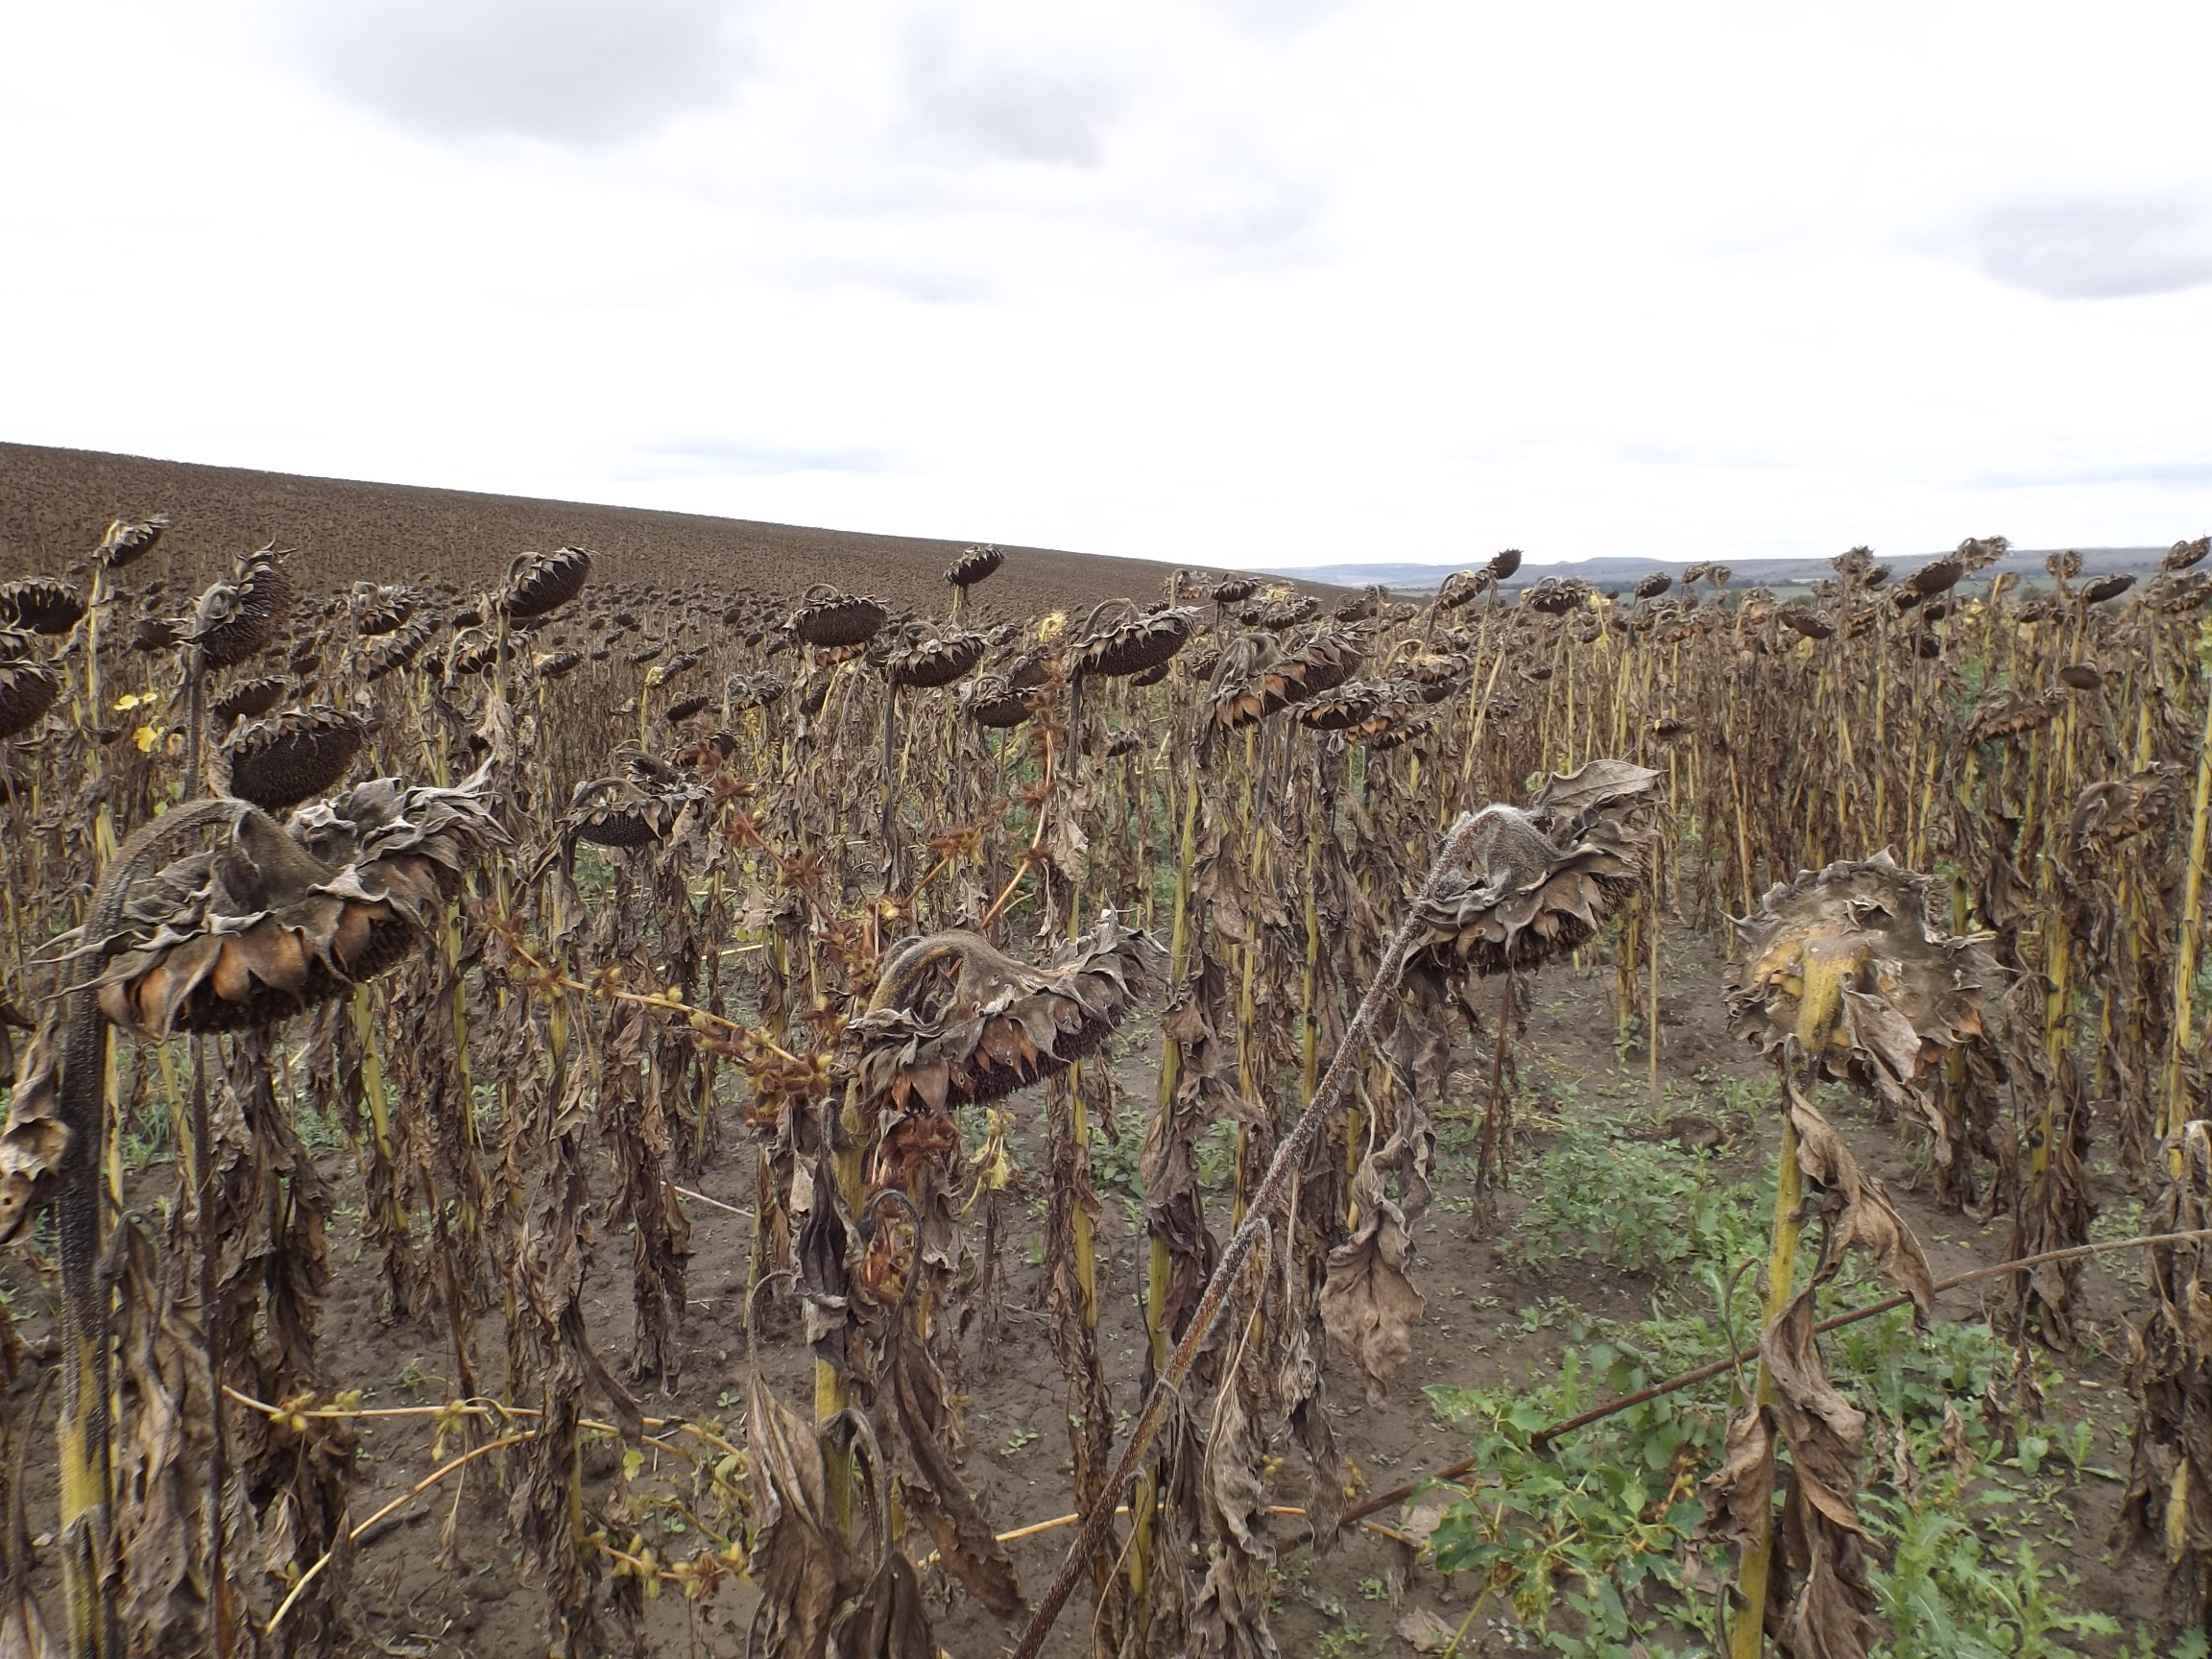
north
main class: Cropland
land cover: Sunflower
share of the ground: > 75 %
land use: Agriculture (excluding fallow land and kitchen gardens)
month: September
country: BG
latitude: 43.0873
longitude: 27.5080
